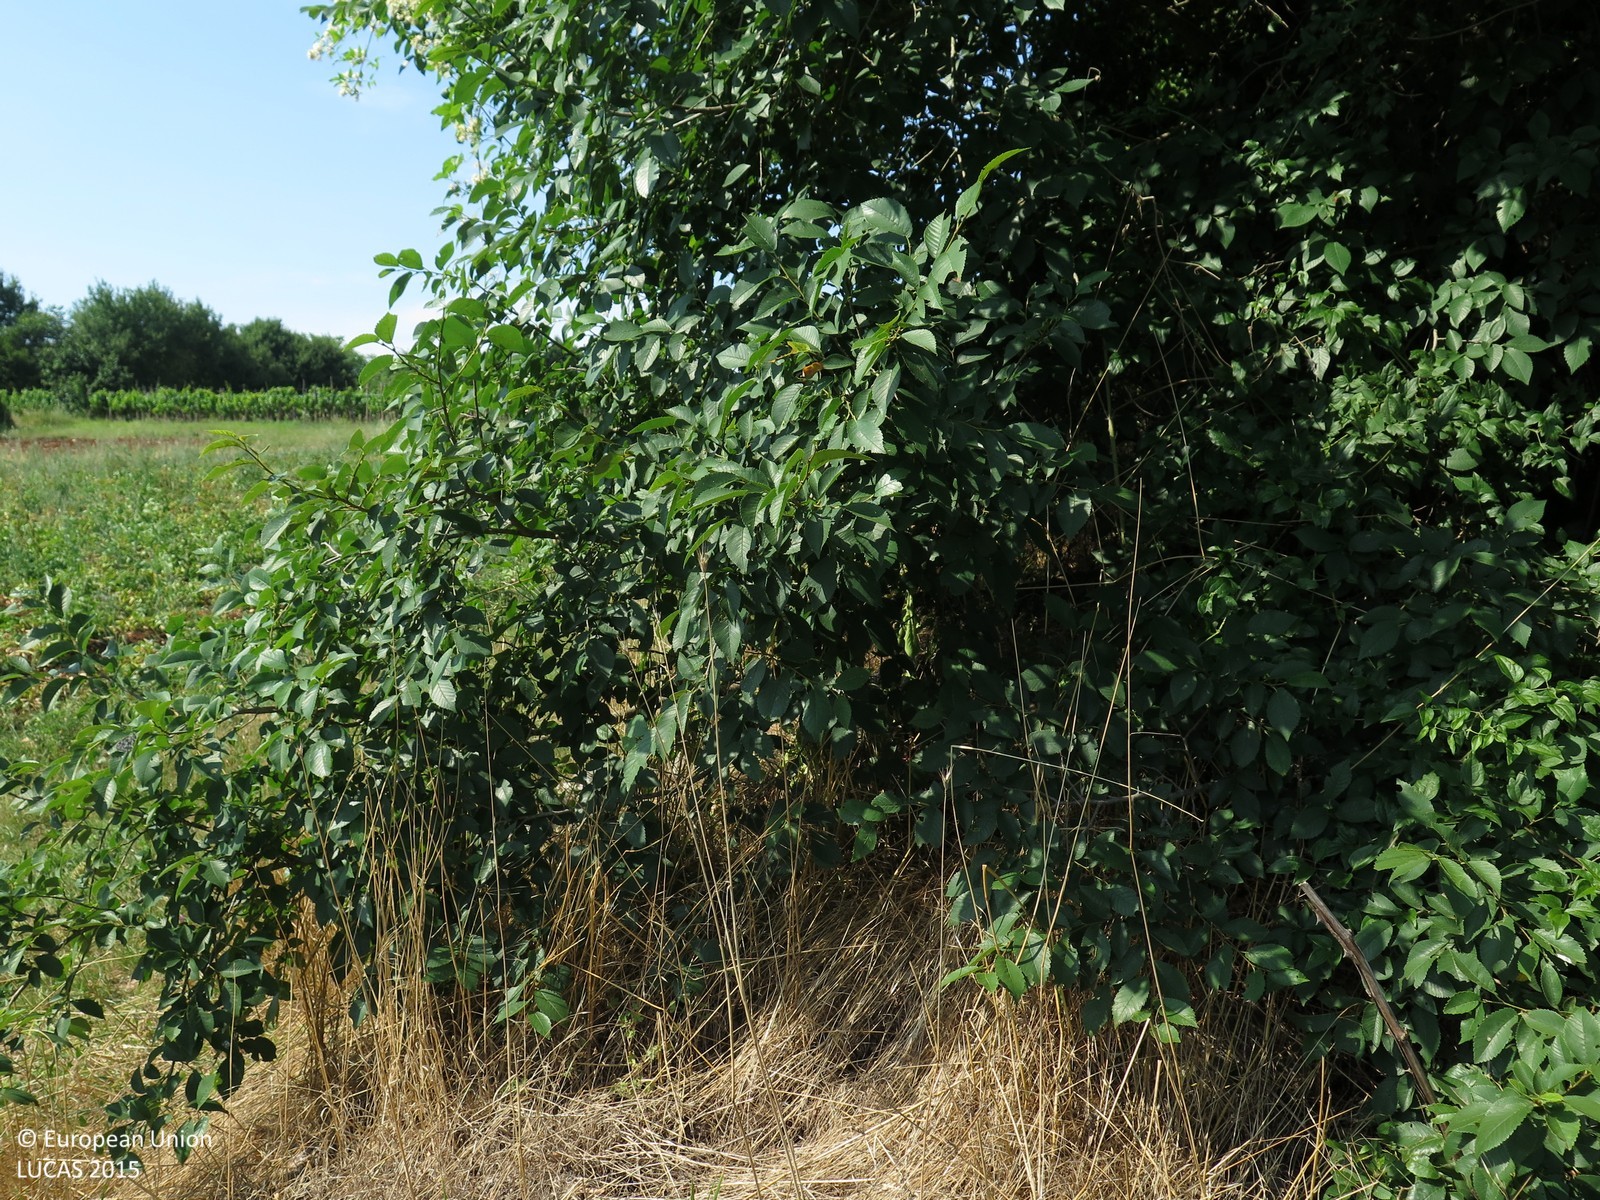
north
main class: Shrubland
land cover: Shrubland with sparse tree cover
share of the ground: > 75 %
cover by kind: shrubs 75 %, herbaceous plants 15 %, broadleaved forest trees 5 %, unconsolidated bare surface 5 %
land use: Semi-natural and natural areas not in use
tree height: > 5 m
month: June
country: HR
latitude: 45.1816
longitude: 13.8507
